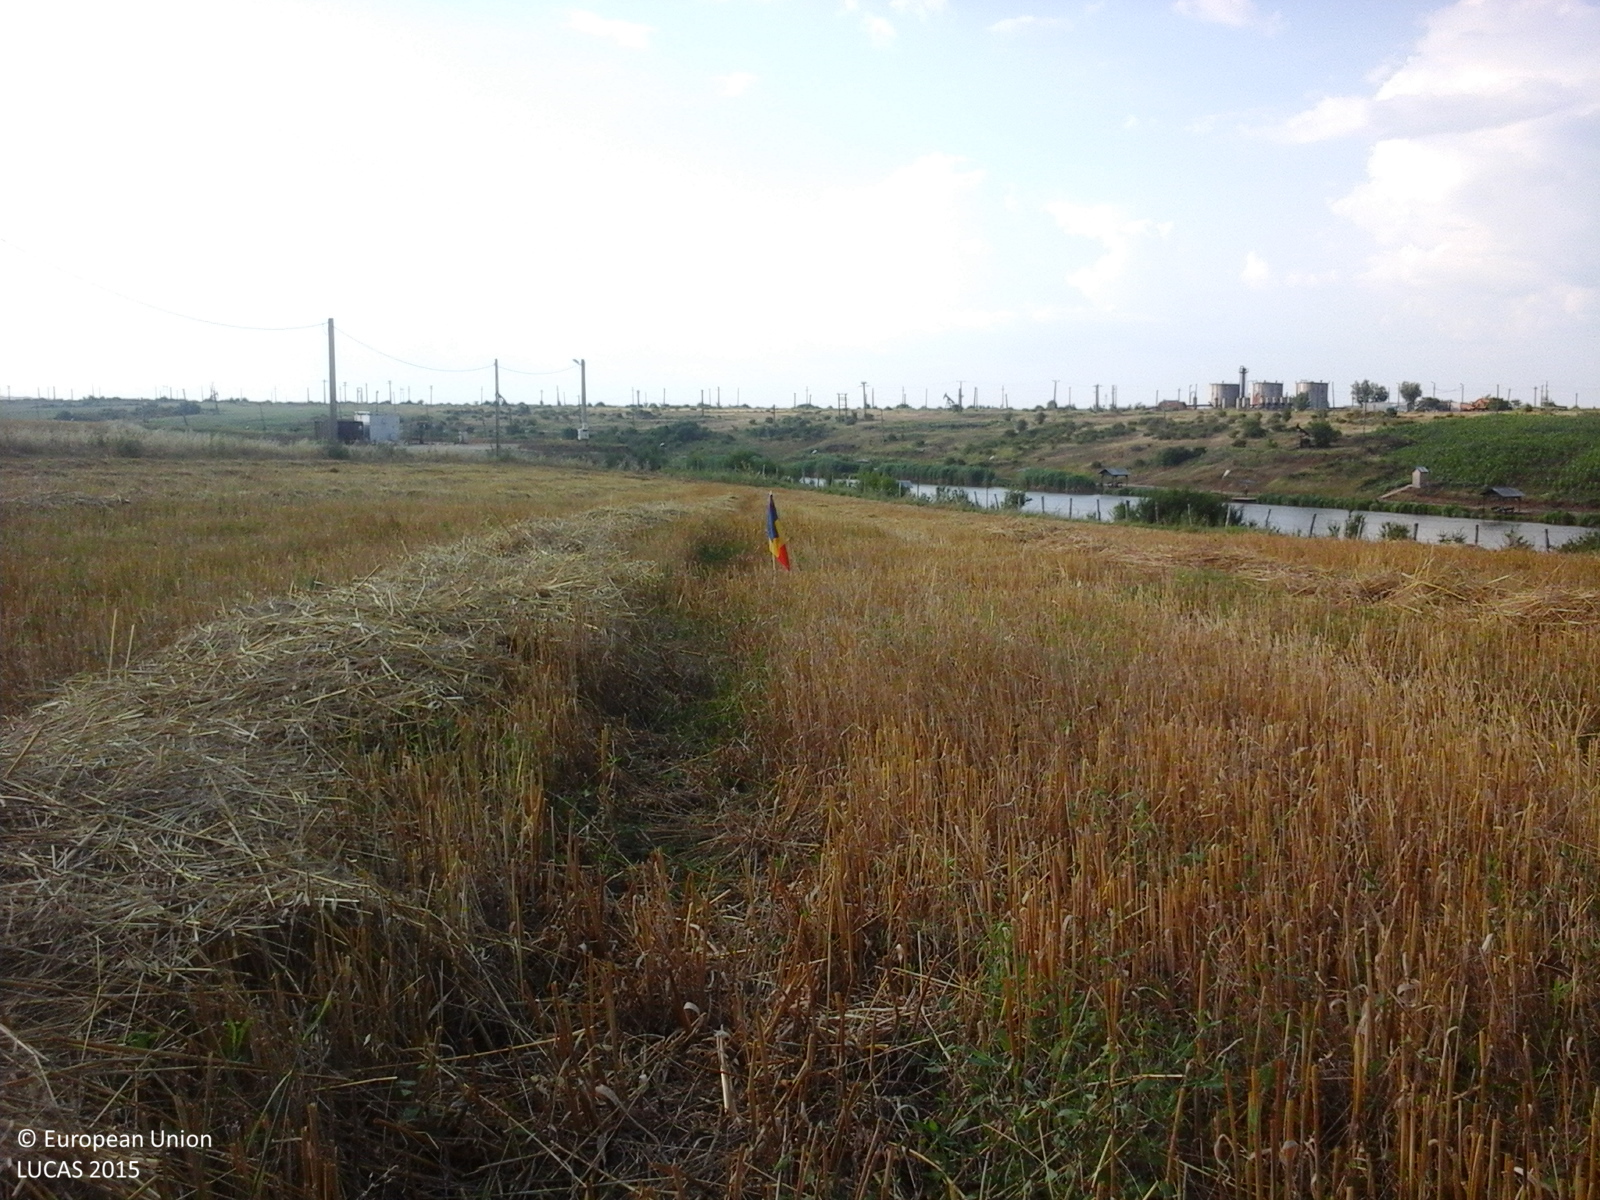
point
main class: Cropland
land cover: Barley
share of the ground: 10 - 25 %
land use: Agriculture (excluding fallow land and kitchen gardens)
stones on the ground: < 10 %
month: July
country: RO
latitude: 44.2483
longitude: 25.8130
